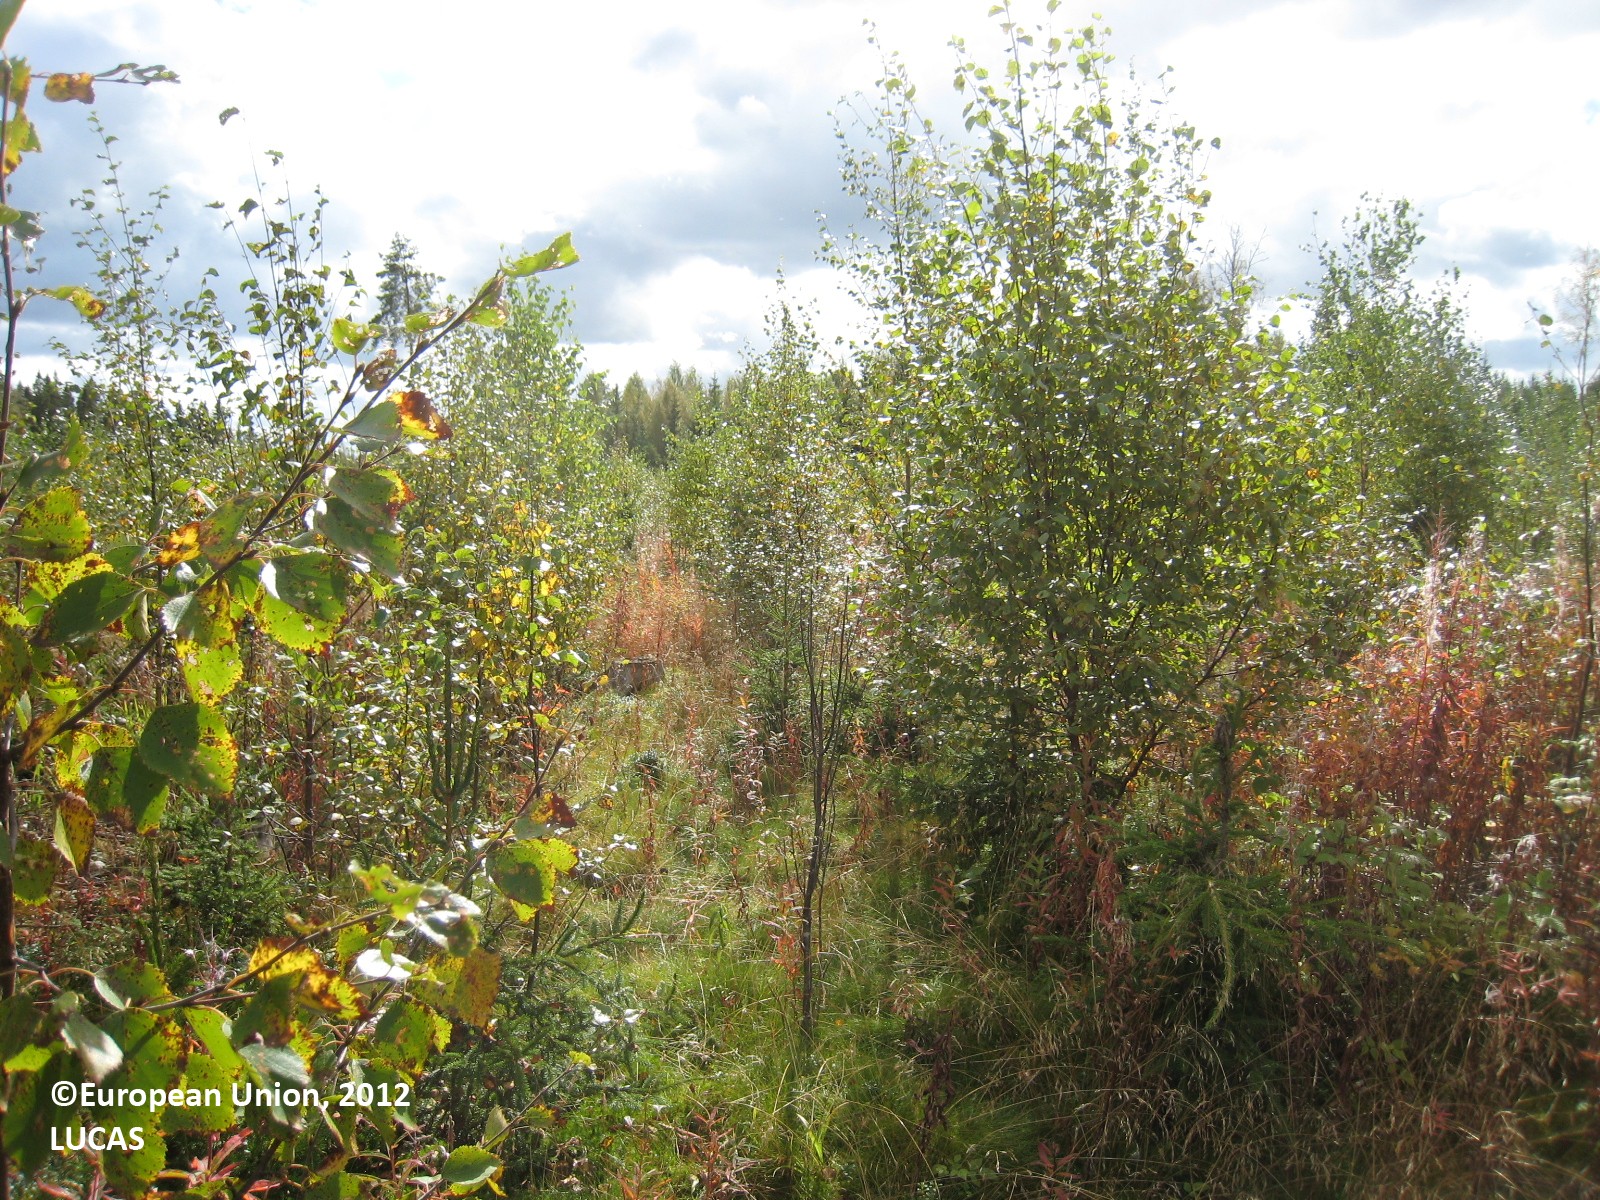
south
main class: Woodland
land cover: Other mixed woodland
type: boreal forest
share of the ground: 50 - 75 %
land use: Forestry
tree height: > 5 m
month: September
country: FI
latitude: 63.0370
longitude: 26.7240
